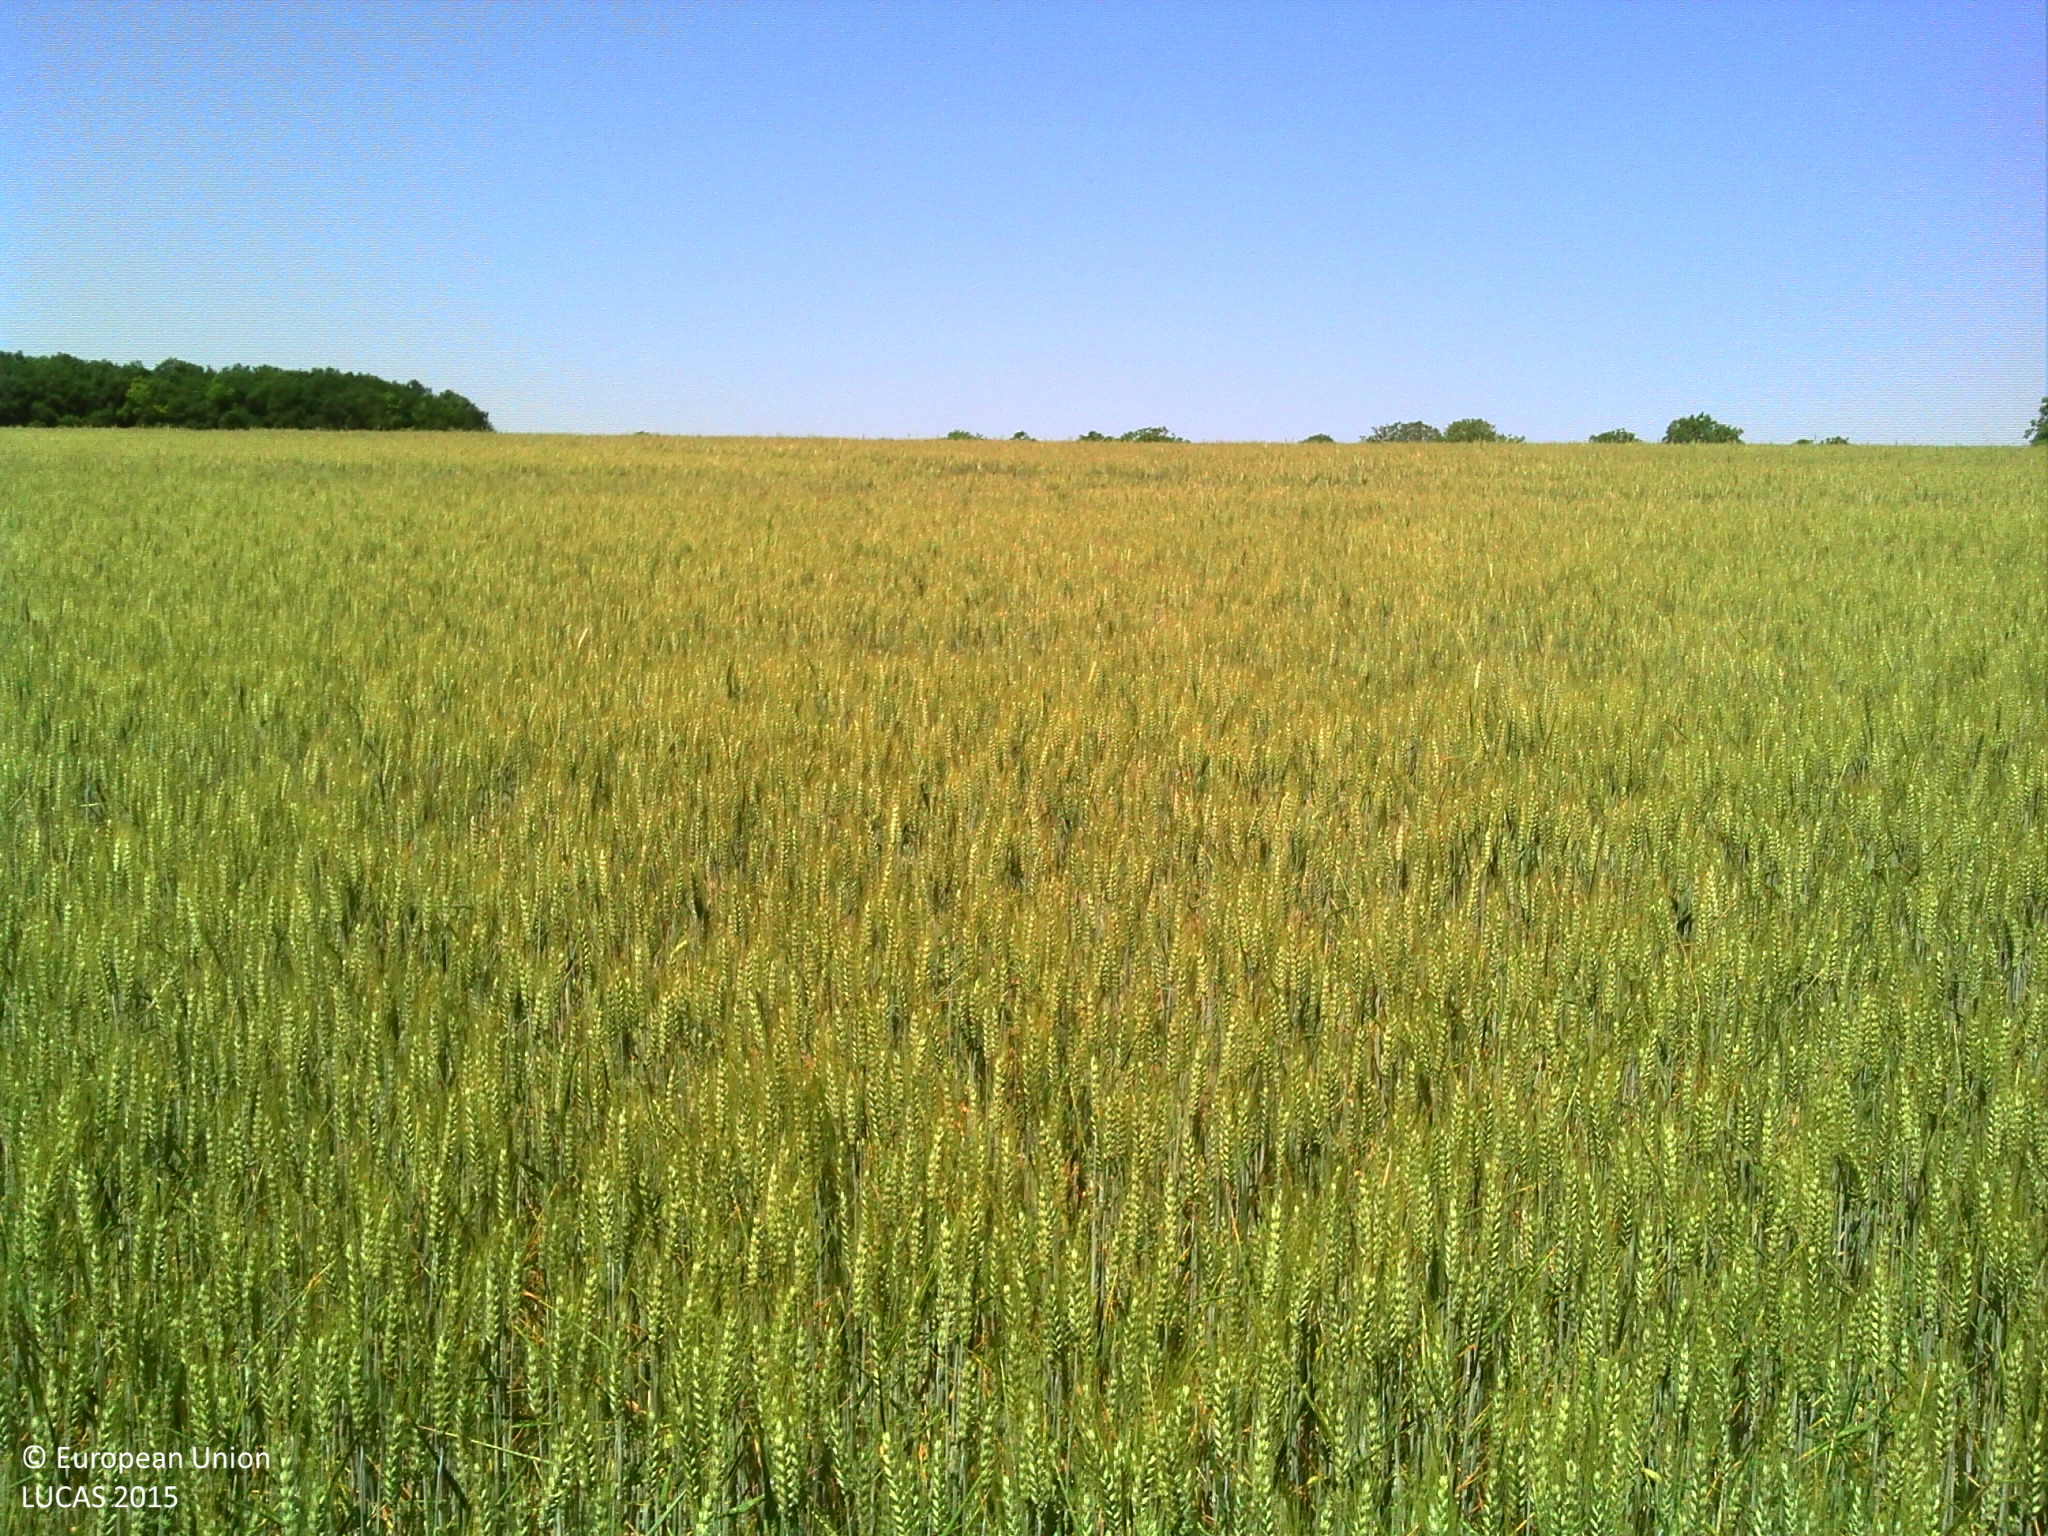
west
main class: Cropland
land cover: Common wheat
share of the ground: > 75 %
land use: Agriculture (excluding fallow land and kitchen gardens)
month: June
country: FR
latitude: 47.0410
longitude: 2.6898
